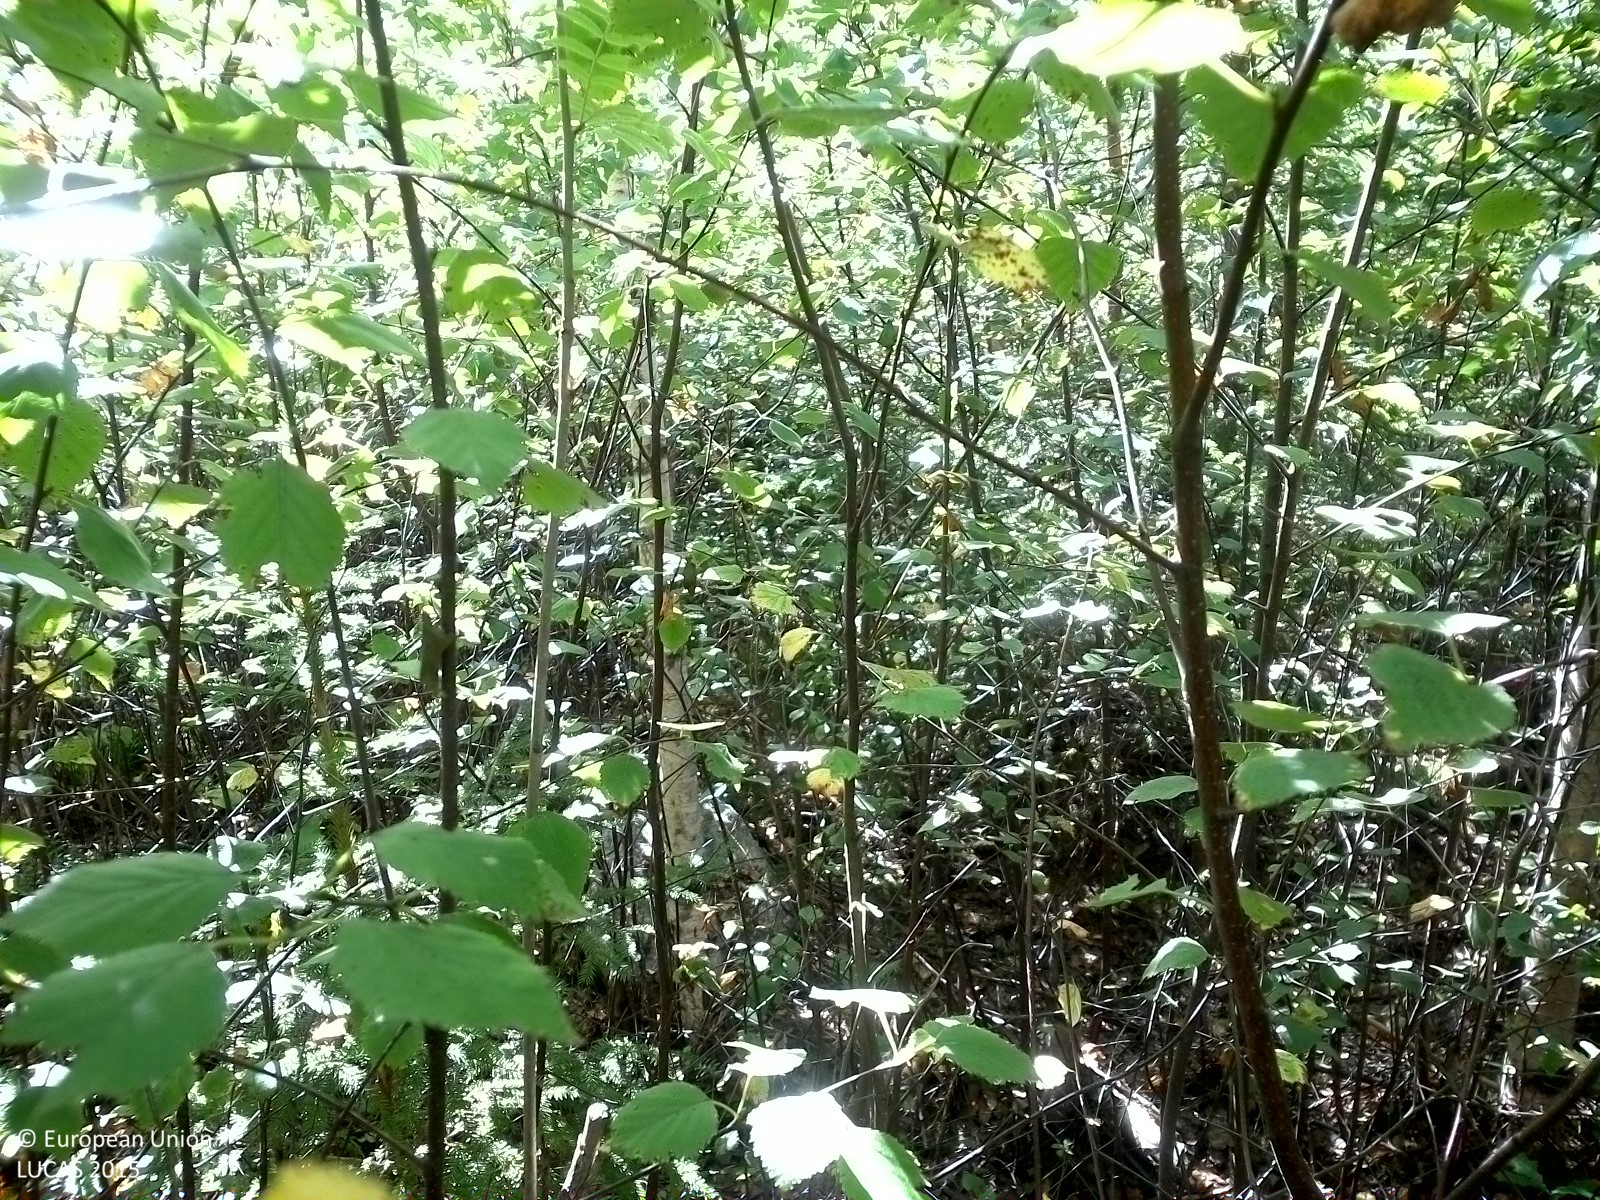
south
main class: Woodland
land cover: Broadleaved woodland
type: hemiboreal forest and nemoral coniferous forest and mixed broadleaved-coniferous forest
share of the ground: > 75 %
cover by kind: broadleaved forest trees 90 %, herbaceous plants 5 %, unconsolidated bare surface 5 %
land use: Forestry
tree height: < 5 m
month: August
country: SE
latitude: 59.2469
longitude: 15.4096
